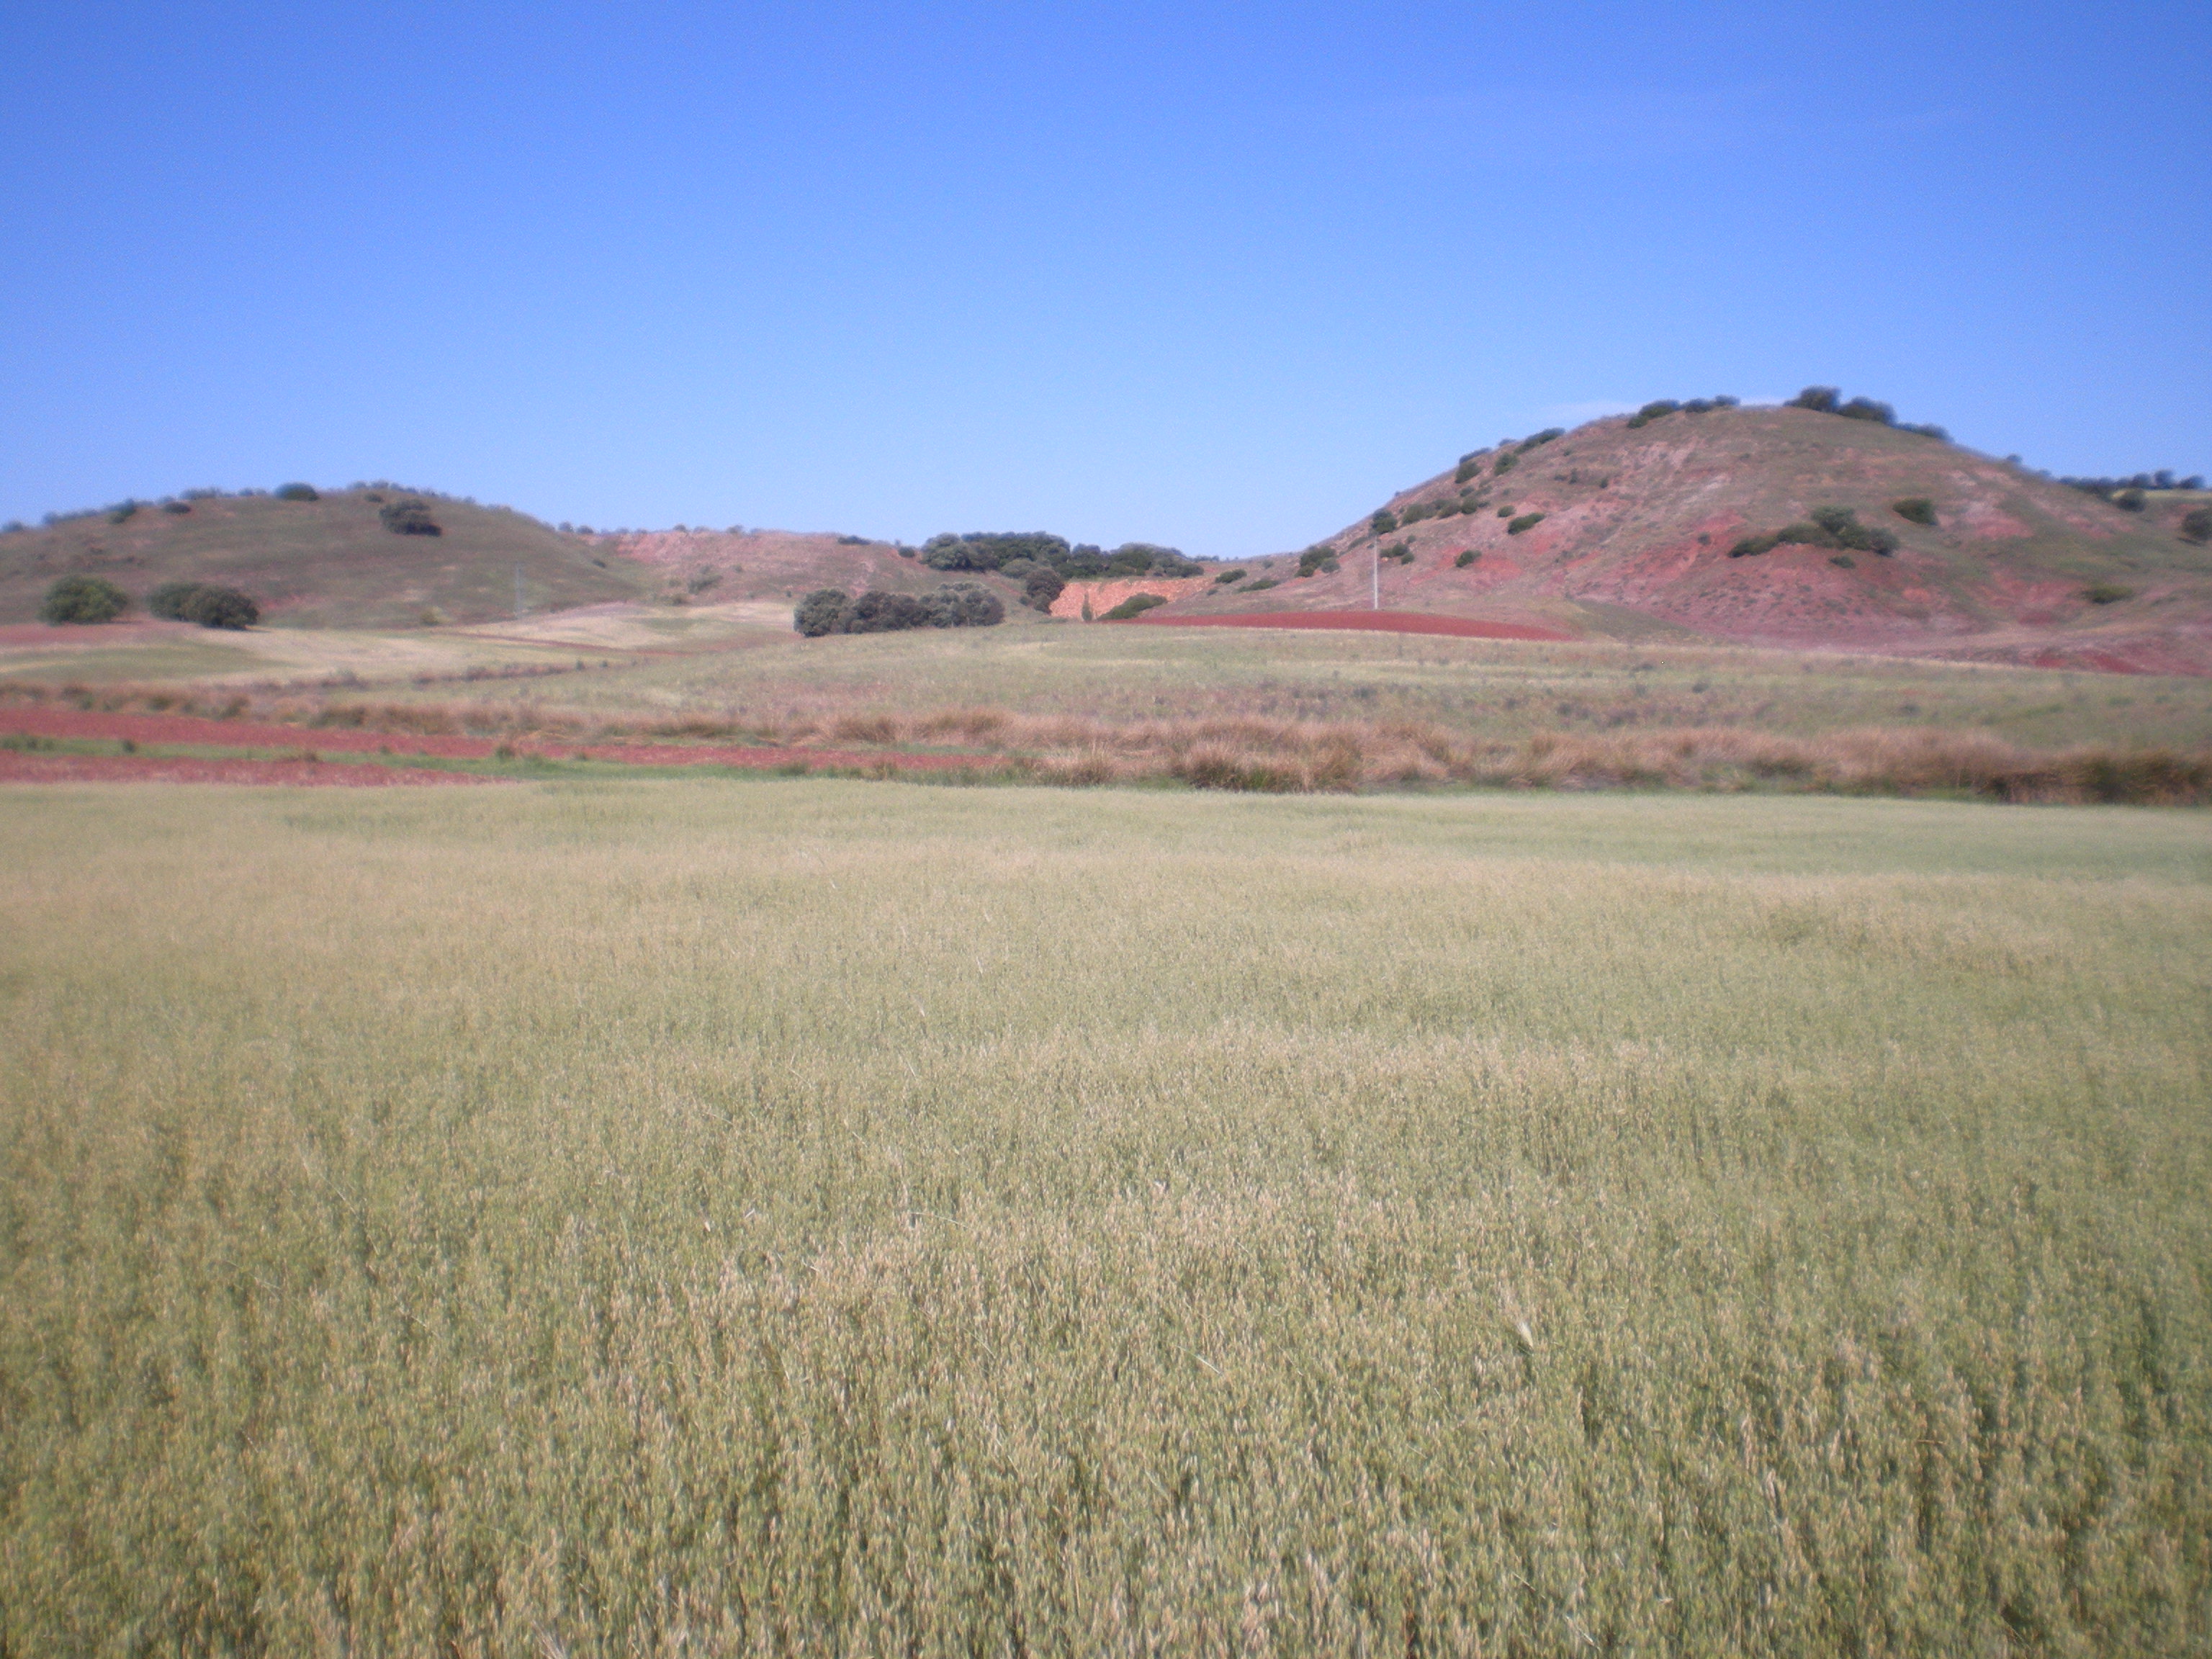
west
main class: Cropland
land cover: Oats
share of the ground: > 75 %
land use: Agriculture (excluding fallow land and kitchen gardens)
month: May
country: ES
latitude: 38.6807
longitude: -2.8910
